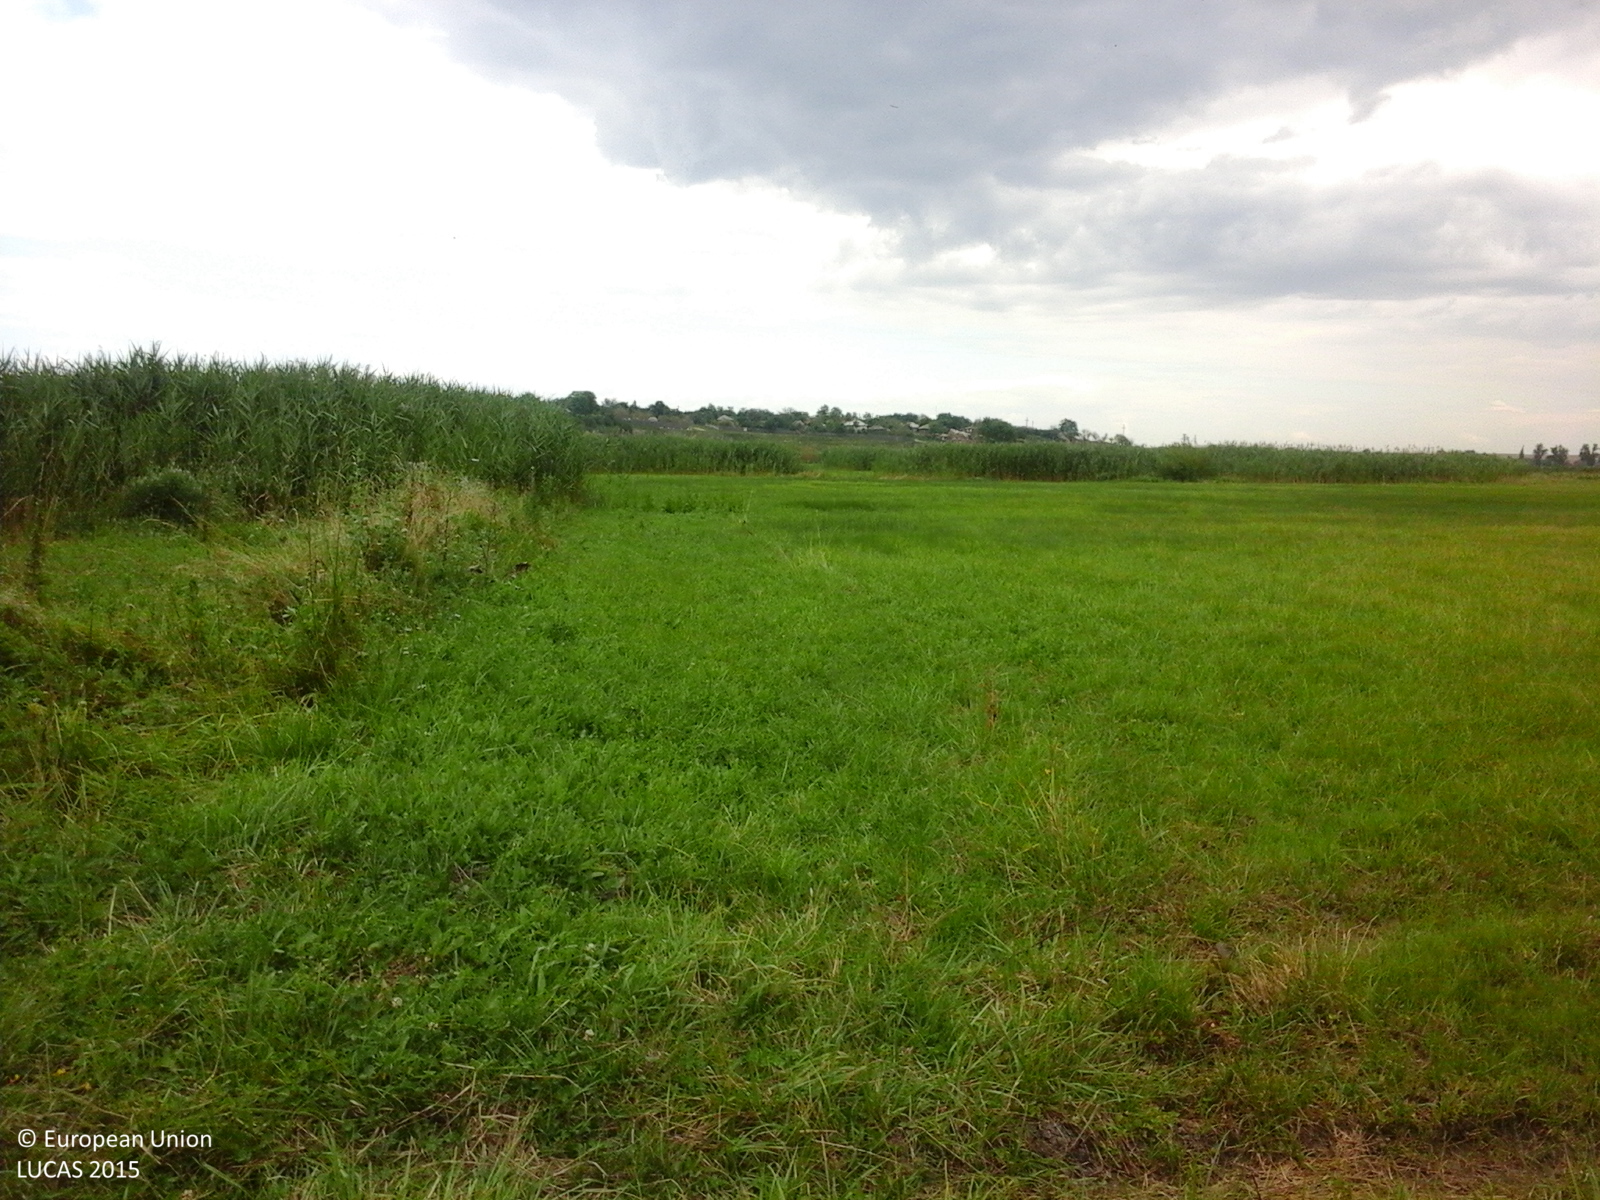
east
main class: Grassland
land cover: Grassland without tree/shrub cover
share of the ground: > 75 %
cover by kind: herbaceous plants 100 %
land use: Agriculture (excluding fallow land and kitchen gardens)
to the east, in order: Grassland without tree/shrub cover; Inland marshes; Grassland without tree/shrub cover
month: July
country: RO
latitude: 44.0143
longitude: 24.8041
